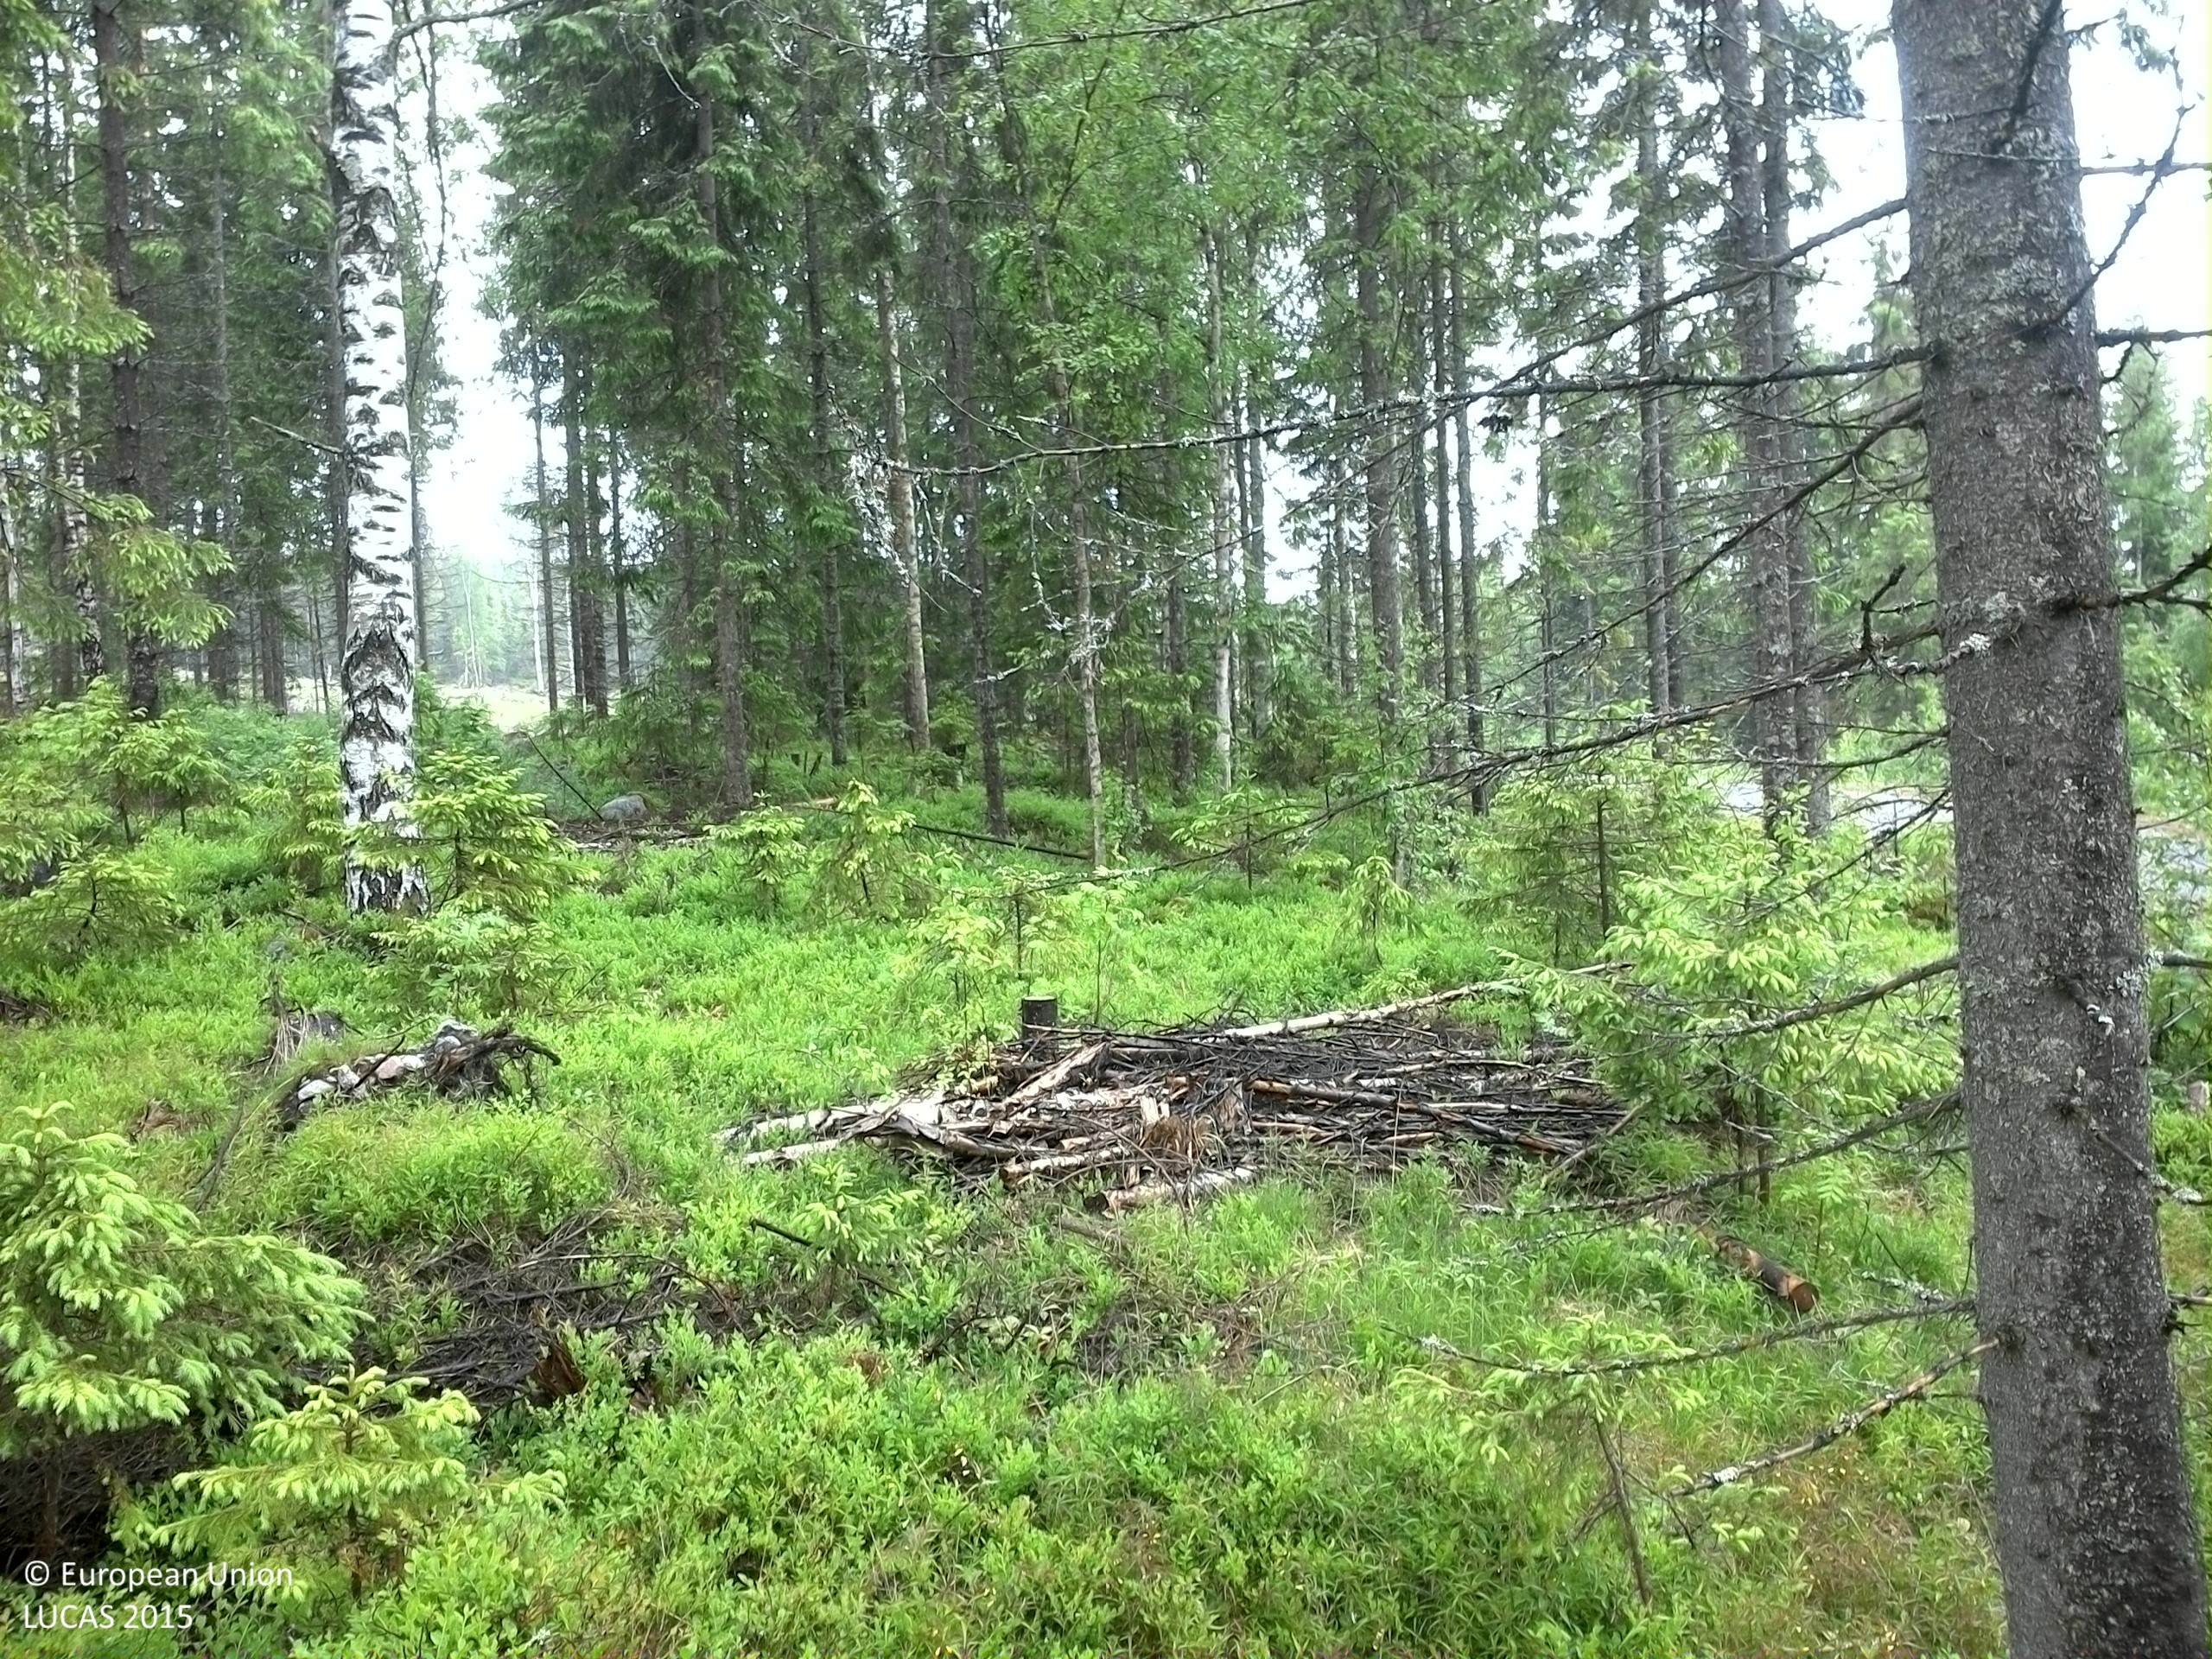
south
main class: Woodland
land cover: Spruce dominated mixed woodland
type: boreal forest
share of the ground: > 75 %
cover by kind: coniferous forest trees 60 %, broadleaved forest trees 20 %, shrubs 15 %, herbaceous plants 5 %
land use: Forestry
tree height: > 5 m
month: June
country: SE
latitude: 62.7669
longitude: 17.9124
